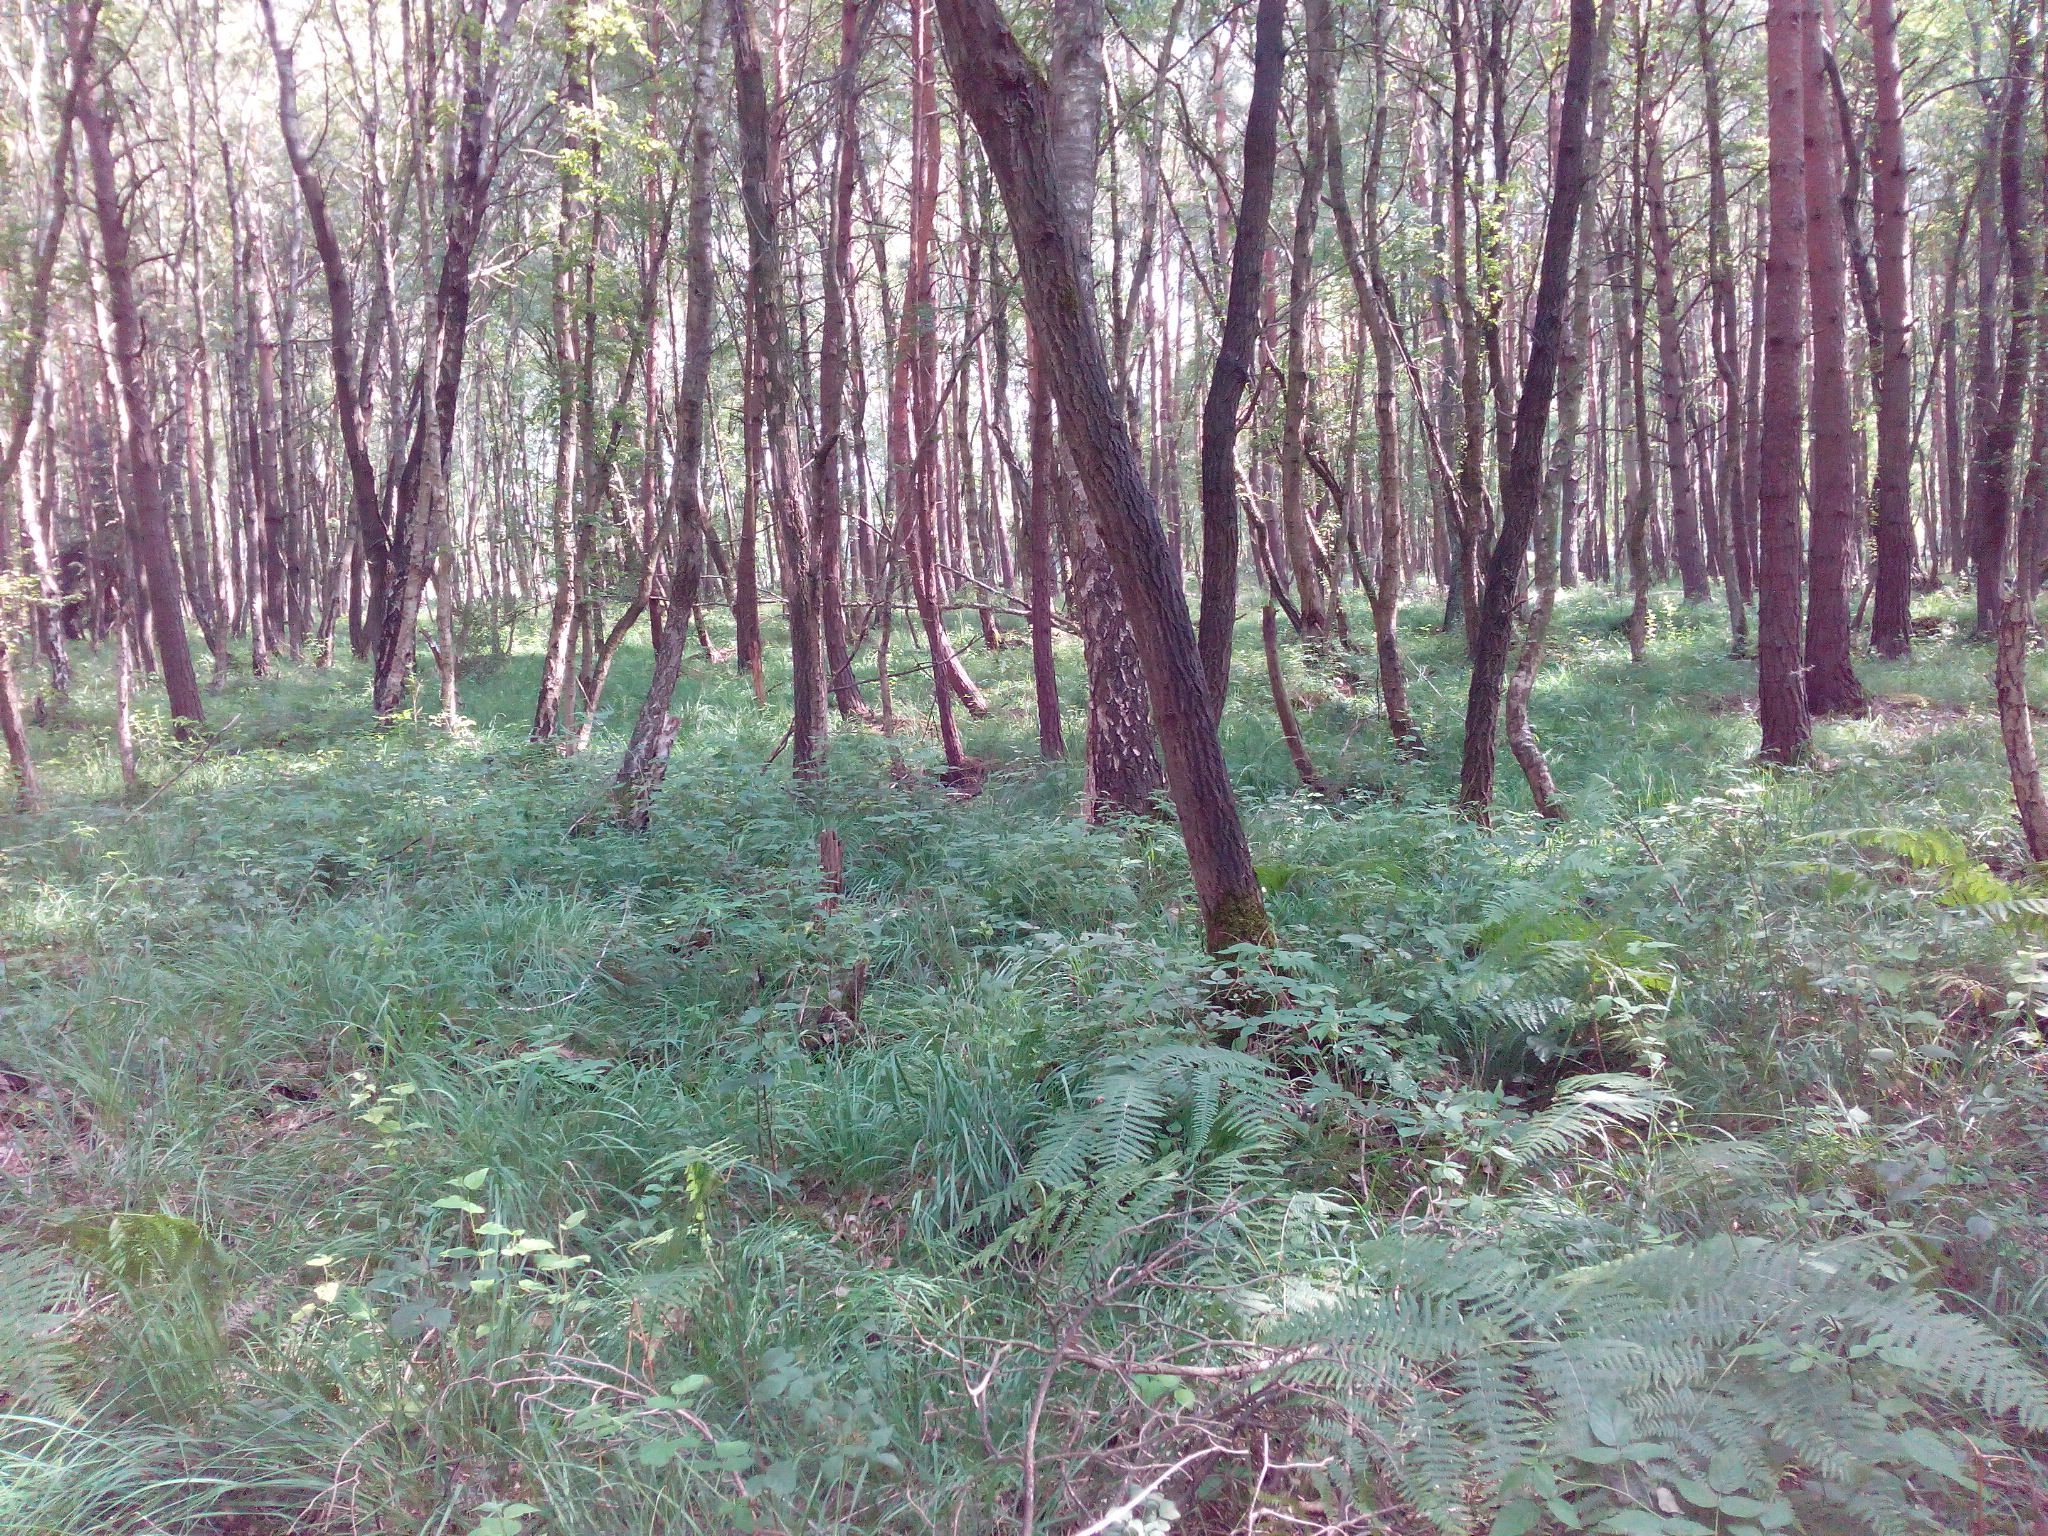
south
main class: Woodland
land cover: Pine dominated mixed woodland
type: hemiboreal forest and nemoral coniferous forest and mixed broadleaved-coniferous forest
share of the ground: > 75 %
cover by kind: broadleaved forest trees 50 %, coniferous forest trees 45 %, herbaceous plants 5 %
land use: Forestry
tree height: > 5 m
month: August
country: DE
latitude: 52.4134
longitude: 9.9265
